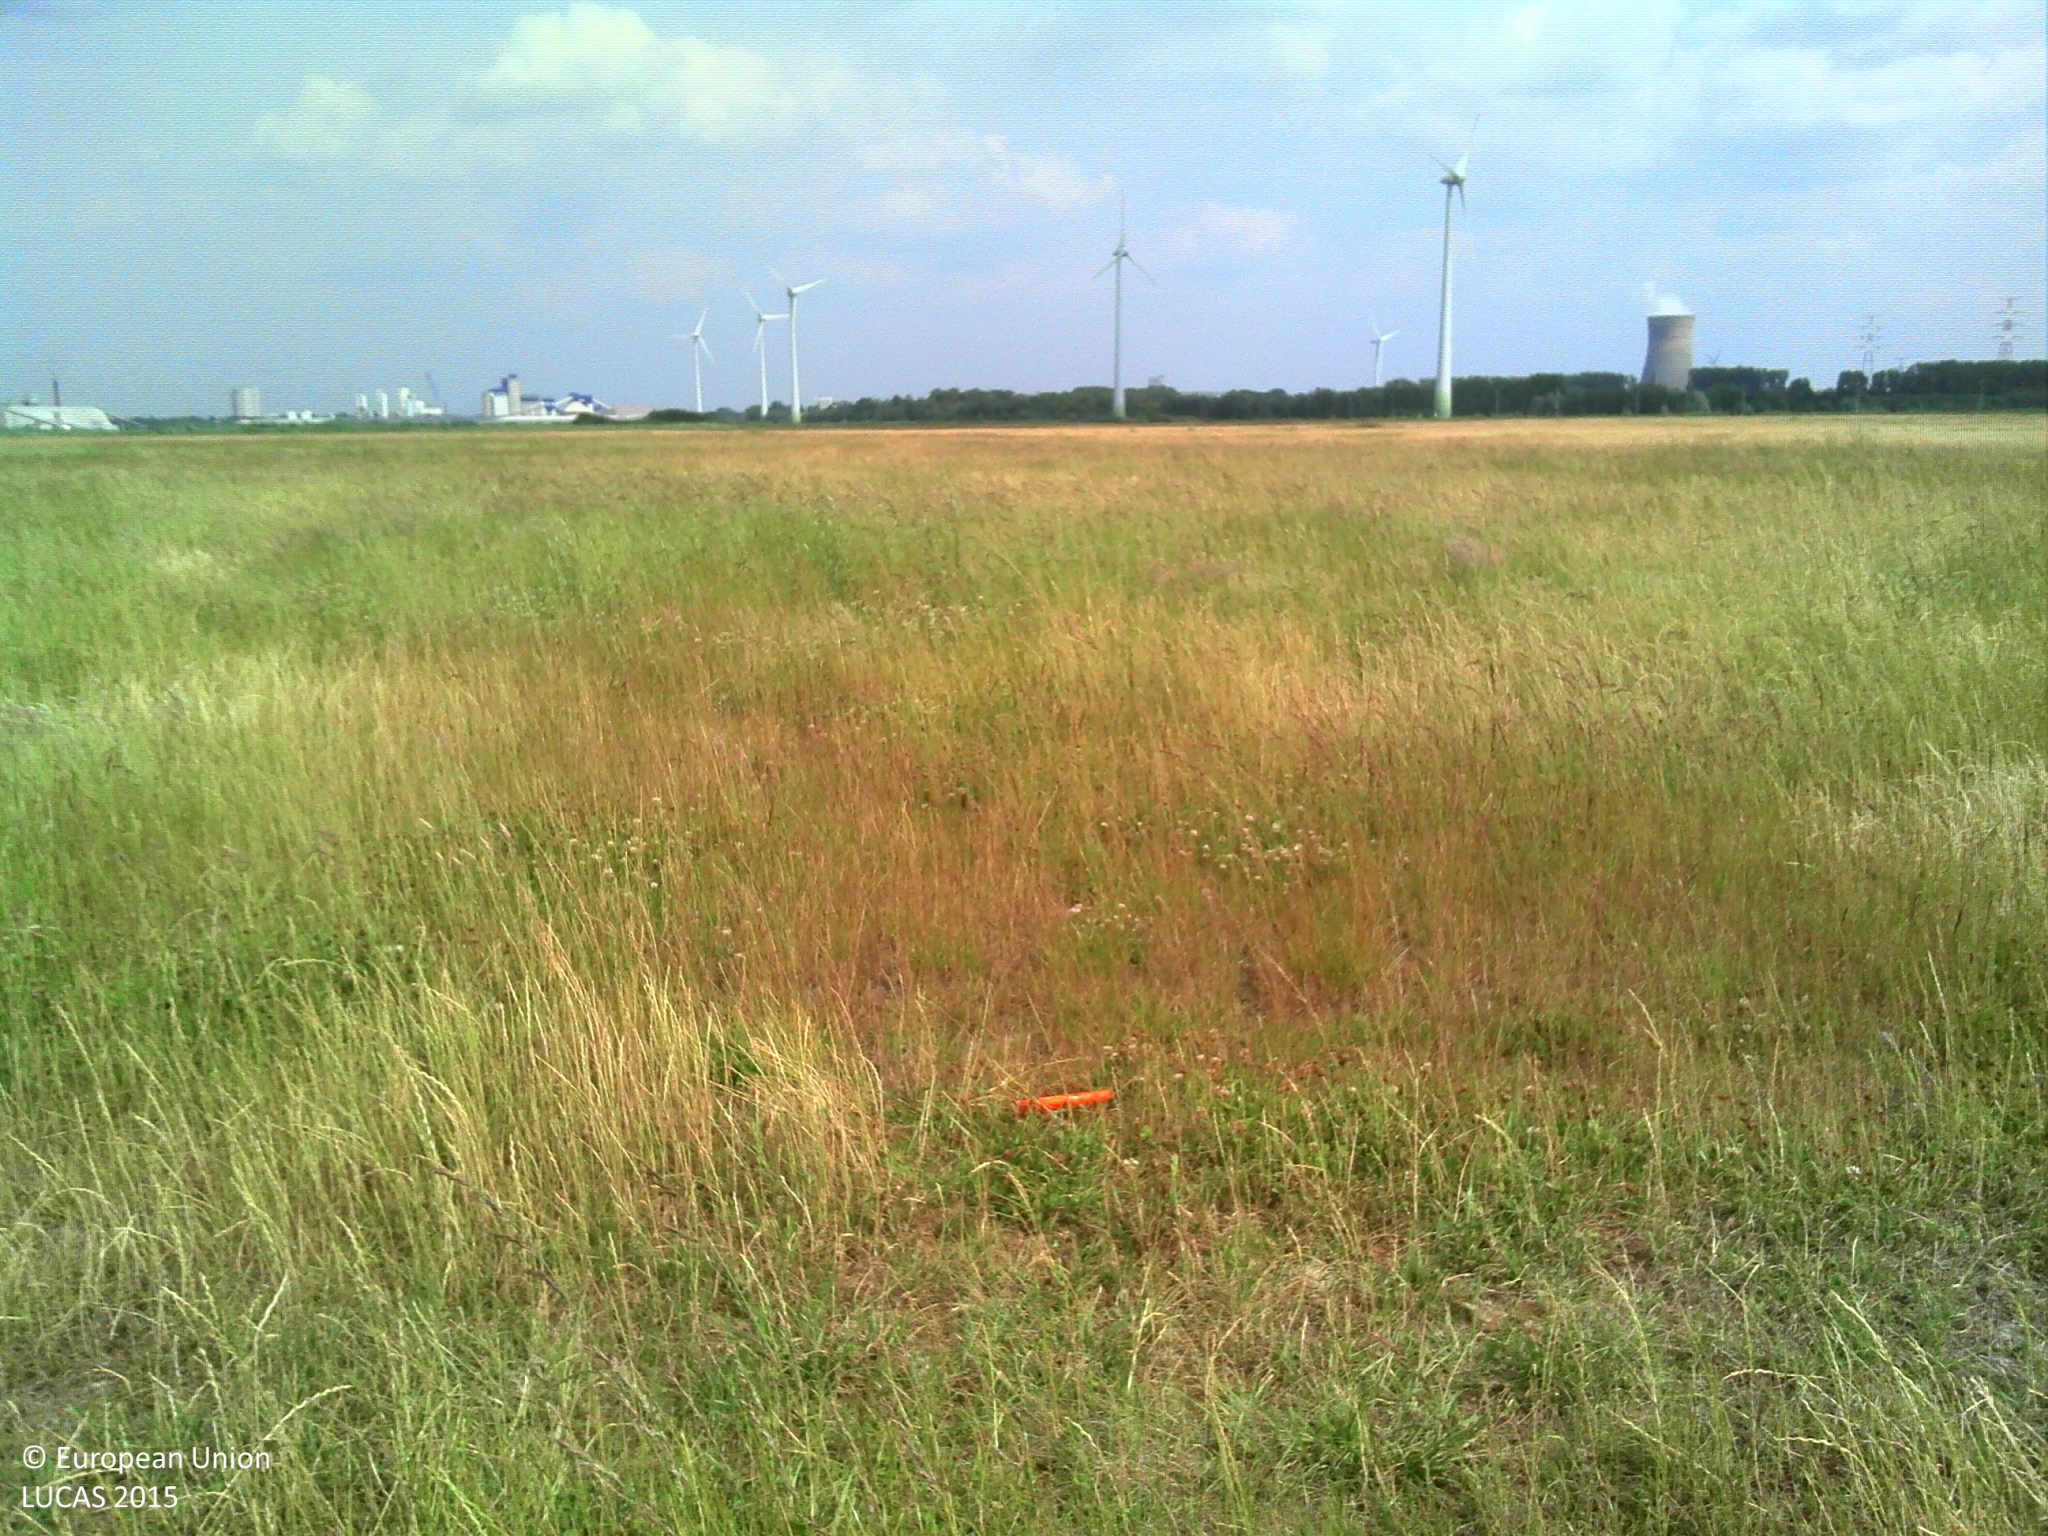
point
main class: Grassland
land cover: Grassland without tree/shrub cover
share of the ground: > 75 %
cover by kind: herbaceous plants 100 %
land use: Semi-natural and natural areas not in use
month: June
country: BE
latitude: 51.1487
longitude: 3.7460
